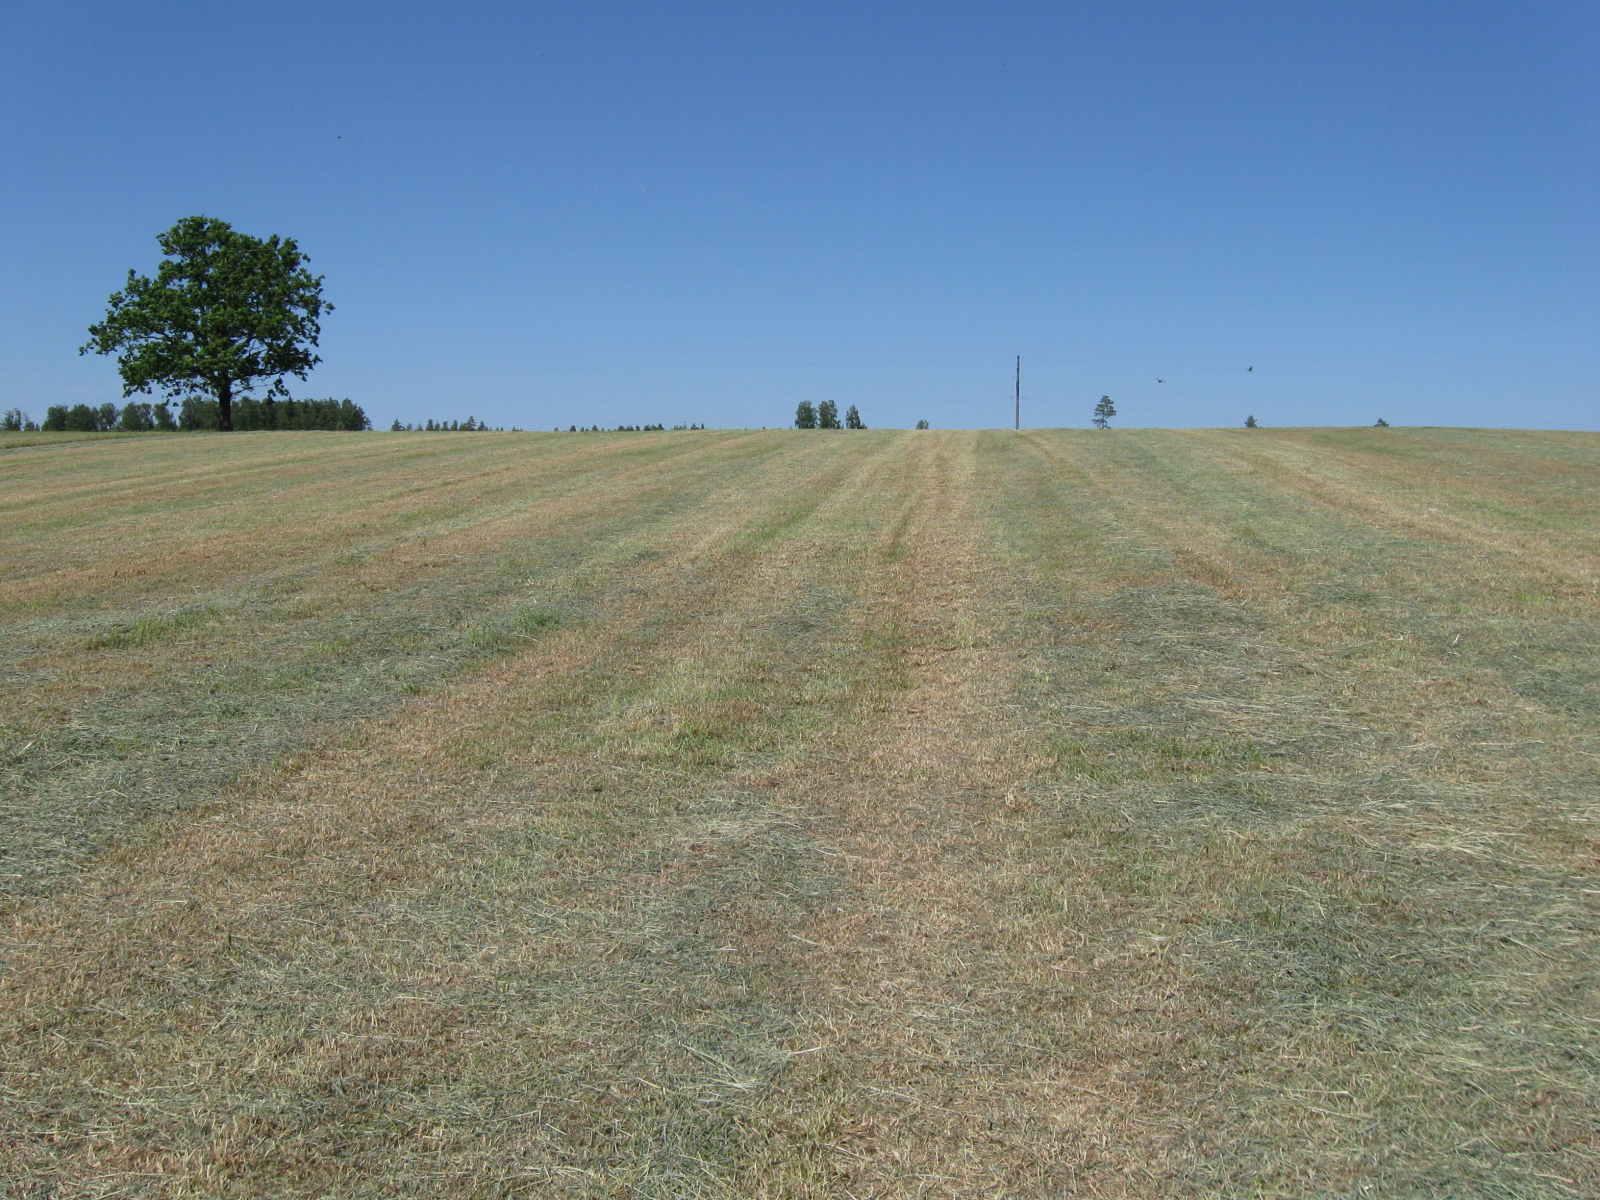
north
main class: Grassland
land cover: Grassland without tree/shrub cover
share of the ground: > 75 %
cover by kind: herbaceous plants 80 %, unconsolidated bare surface 20 %
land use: Agriculture (excluding fallow land and kitchen gardens)
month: June
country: LT
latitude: 54.8099
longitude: 24.0174
